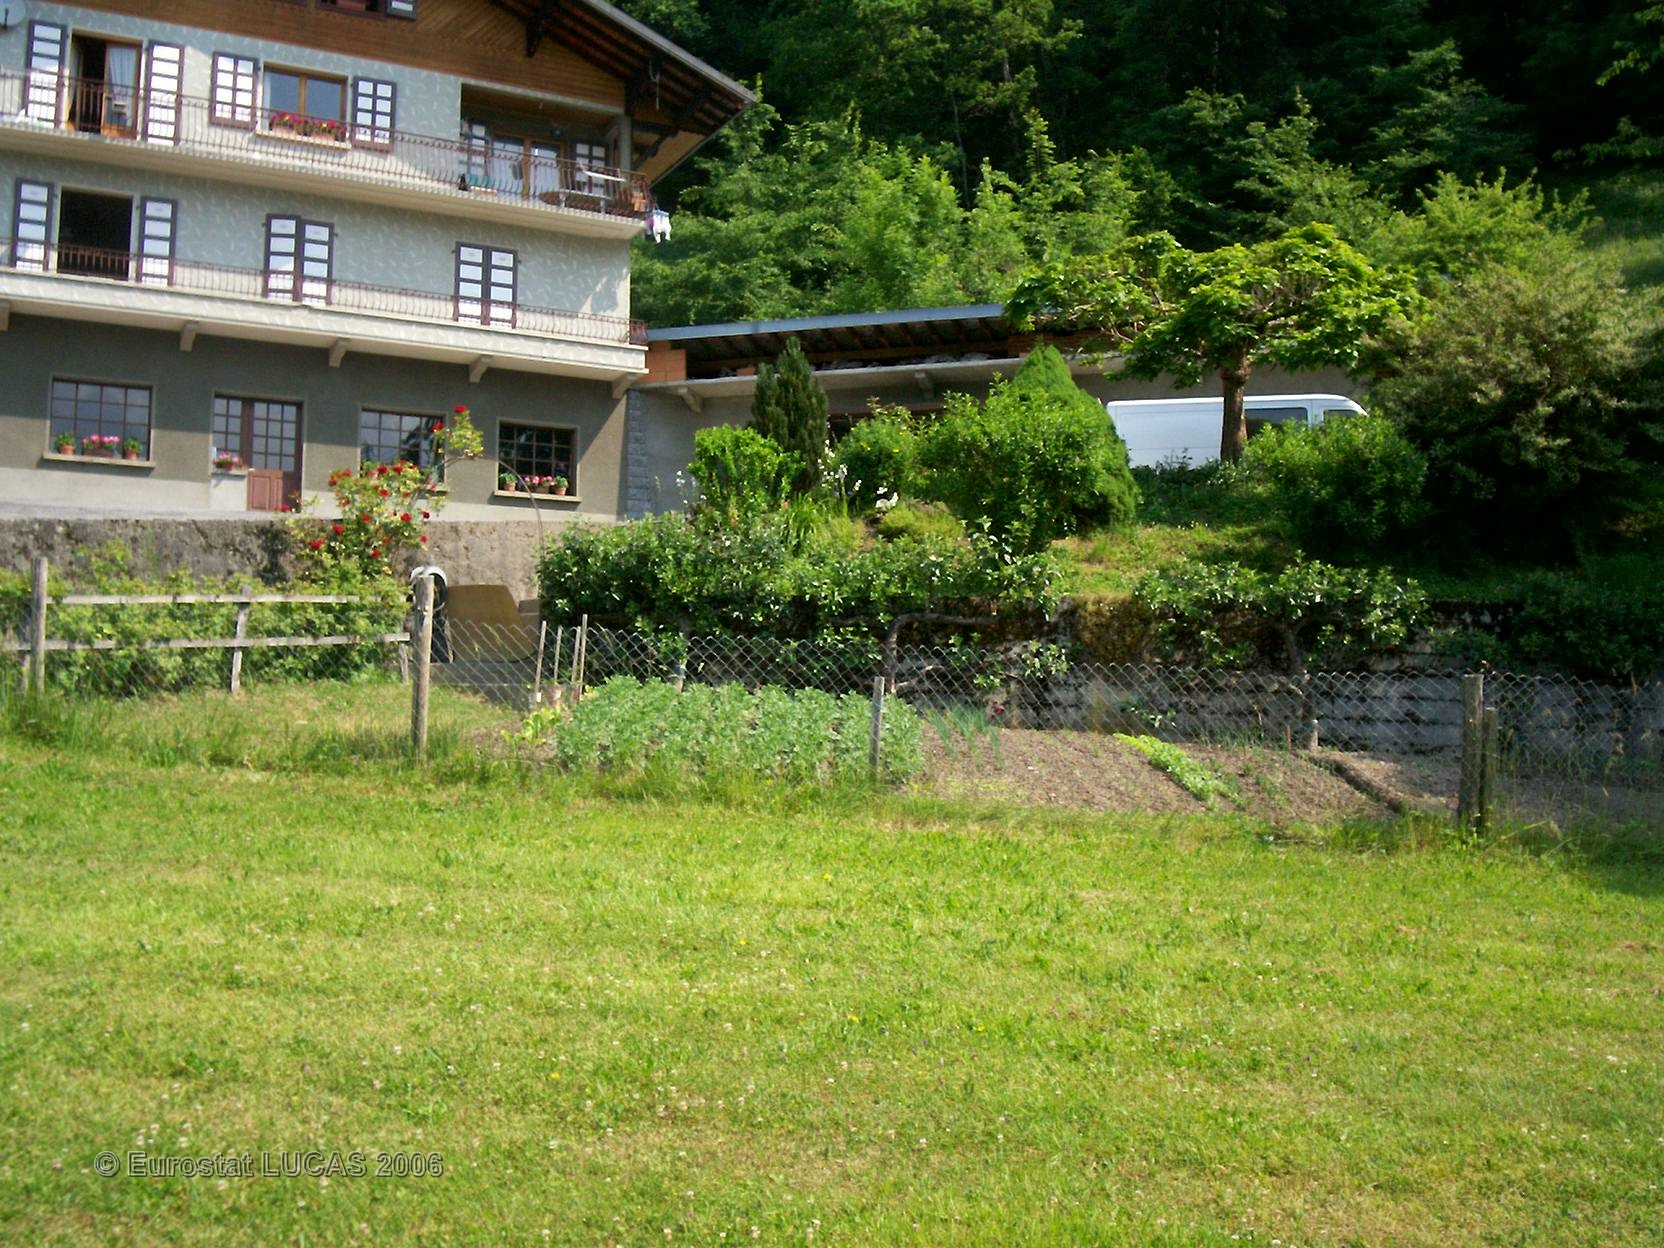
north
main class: Grassland
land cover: Grassland with sparse tree/shrub cover
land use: Agriculture (excluding fallow land and kitchen gardens)
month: June
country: FR
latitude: 46.1006
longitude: 6.6532
